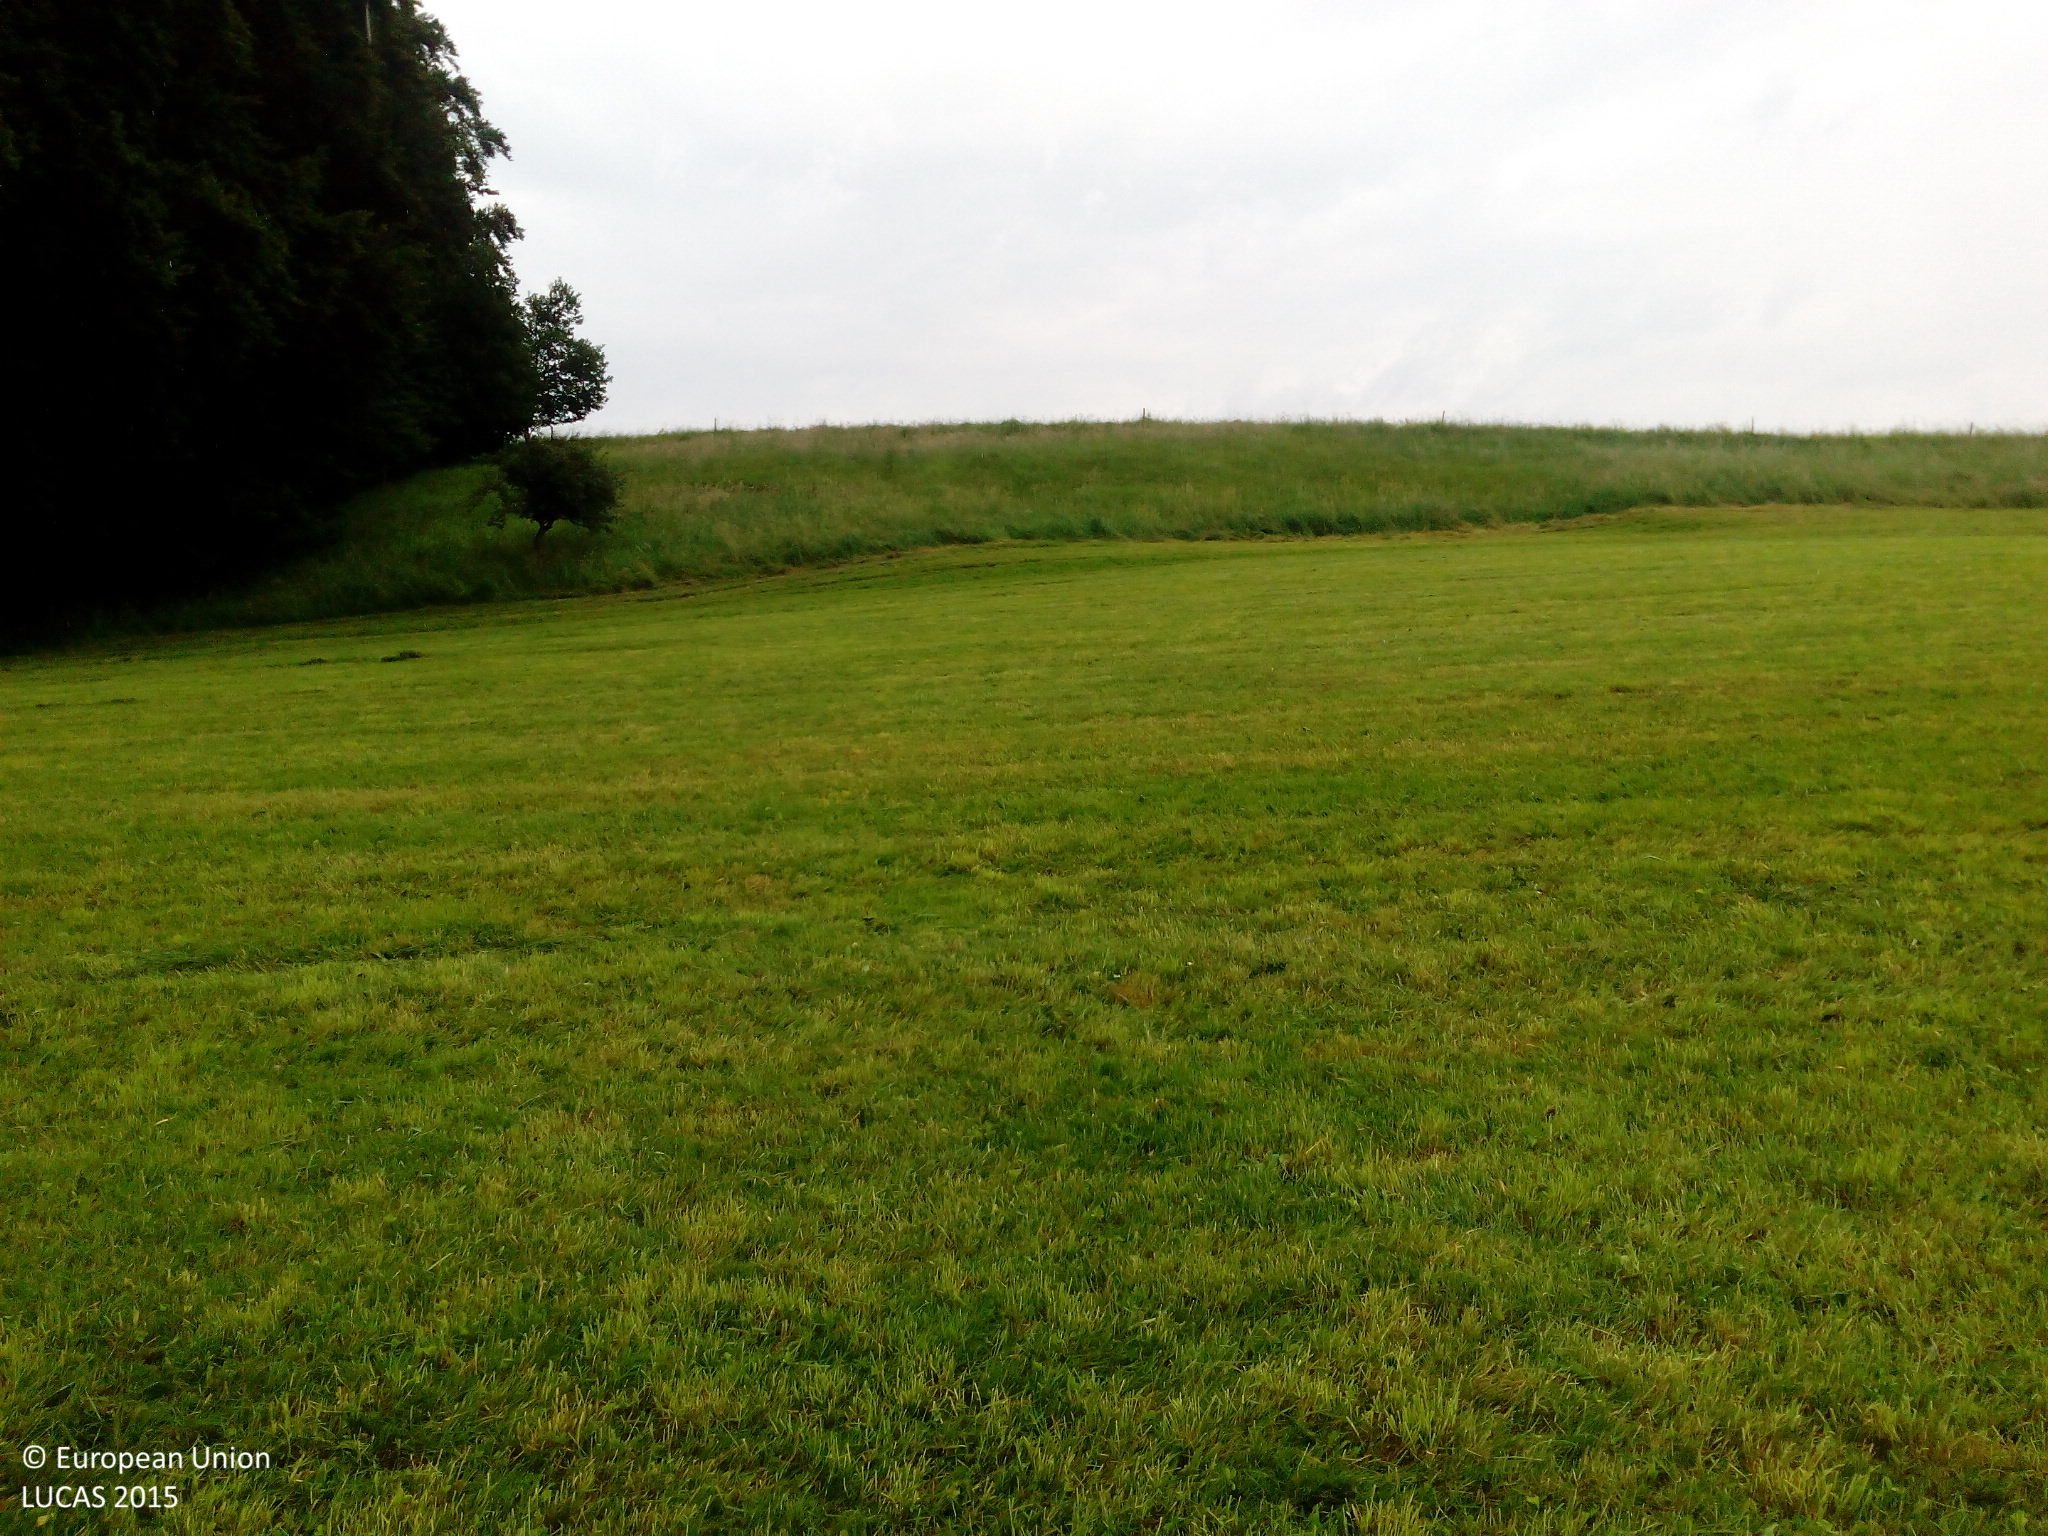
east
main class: Grassland
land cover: Grassland without tree/shrub cover
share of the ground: > 75 %
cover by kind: herbaceous plants 100 %
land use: Agriculture (excluding fallow land and kitchen gardens)
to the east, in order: Grassland without tree/shrub cover; Fences; Grassland without tree/shrub cover; Paved roads, cycling and walking lanes
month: June
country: DE
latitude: 47.9273
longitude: 11.3509
